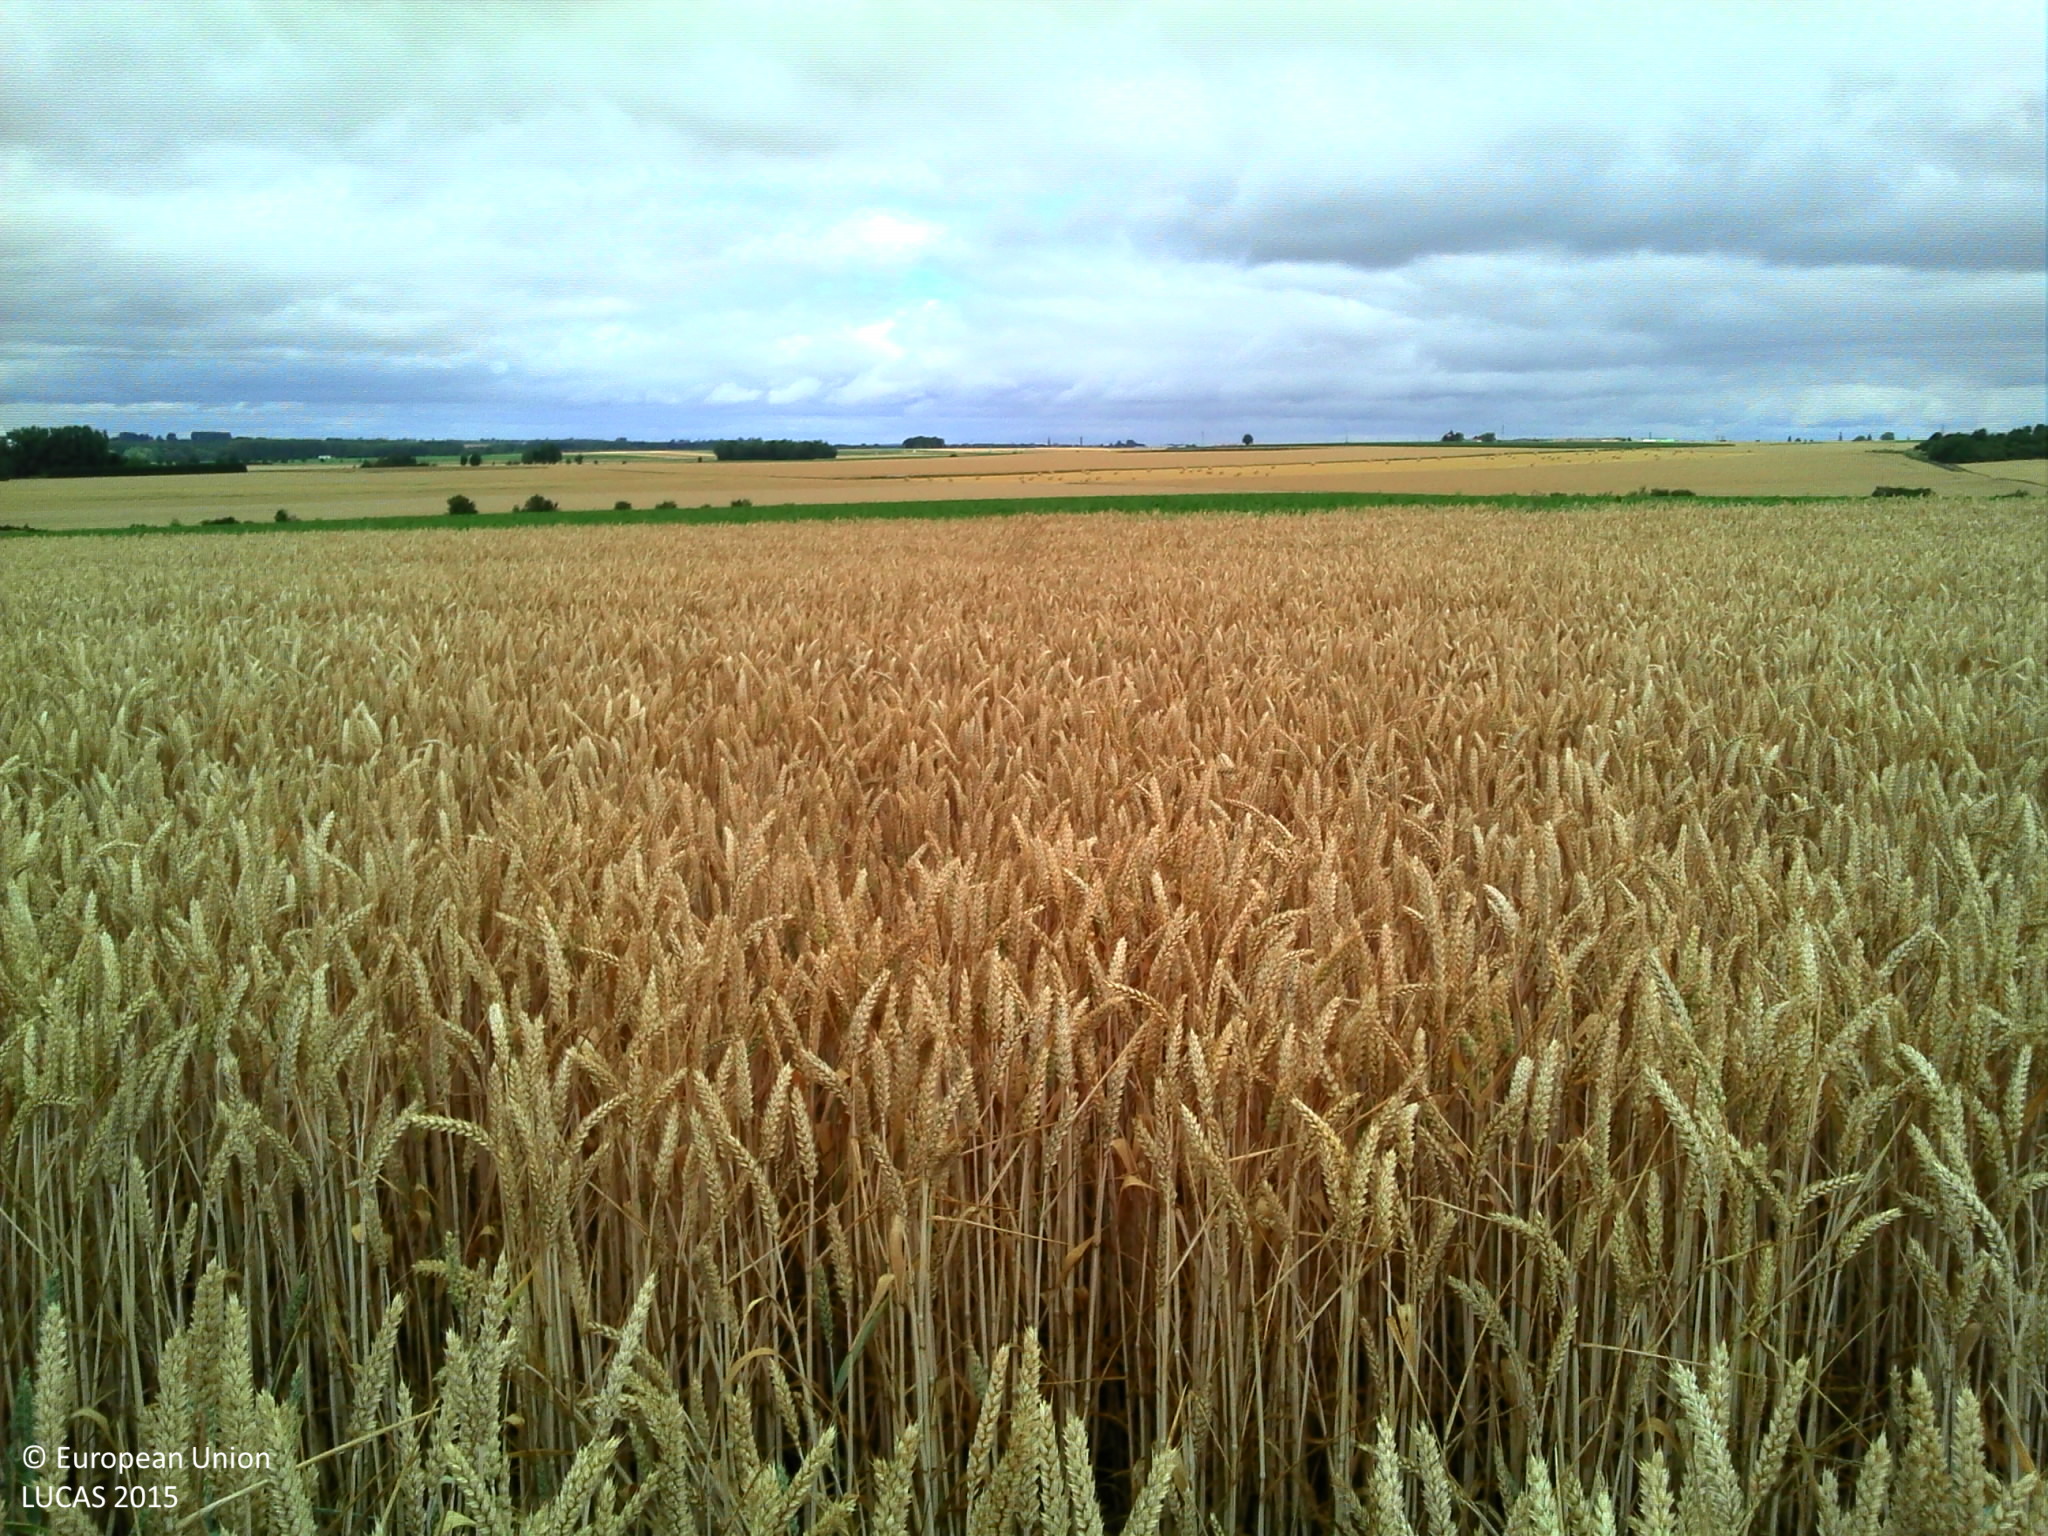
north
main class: Cropland
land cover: Common wheat
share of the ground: > 75 %
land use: Agriculture (excluding fallow land and kitchen gardens)
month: July
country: FR
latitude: 50.1260
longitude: 3.2071
